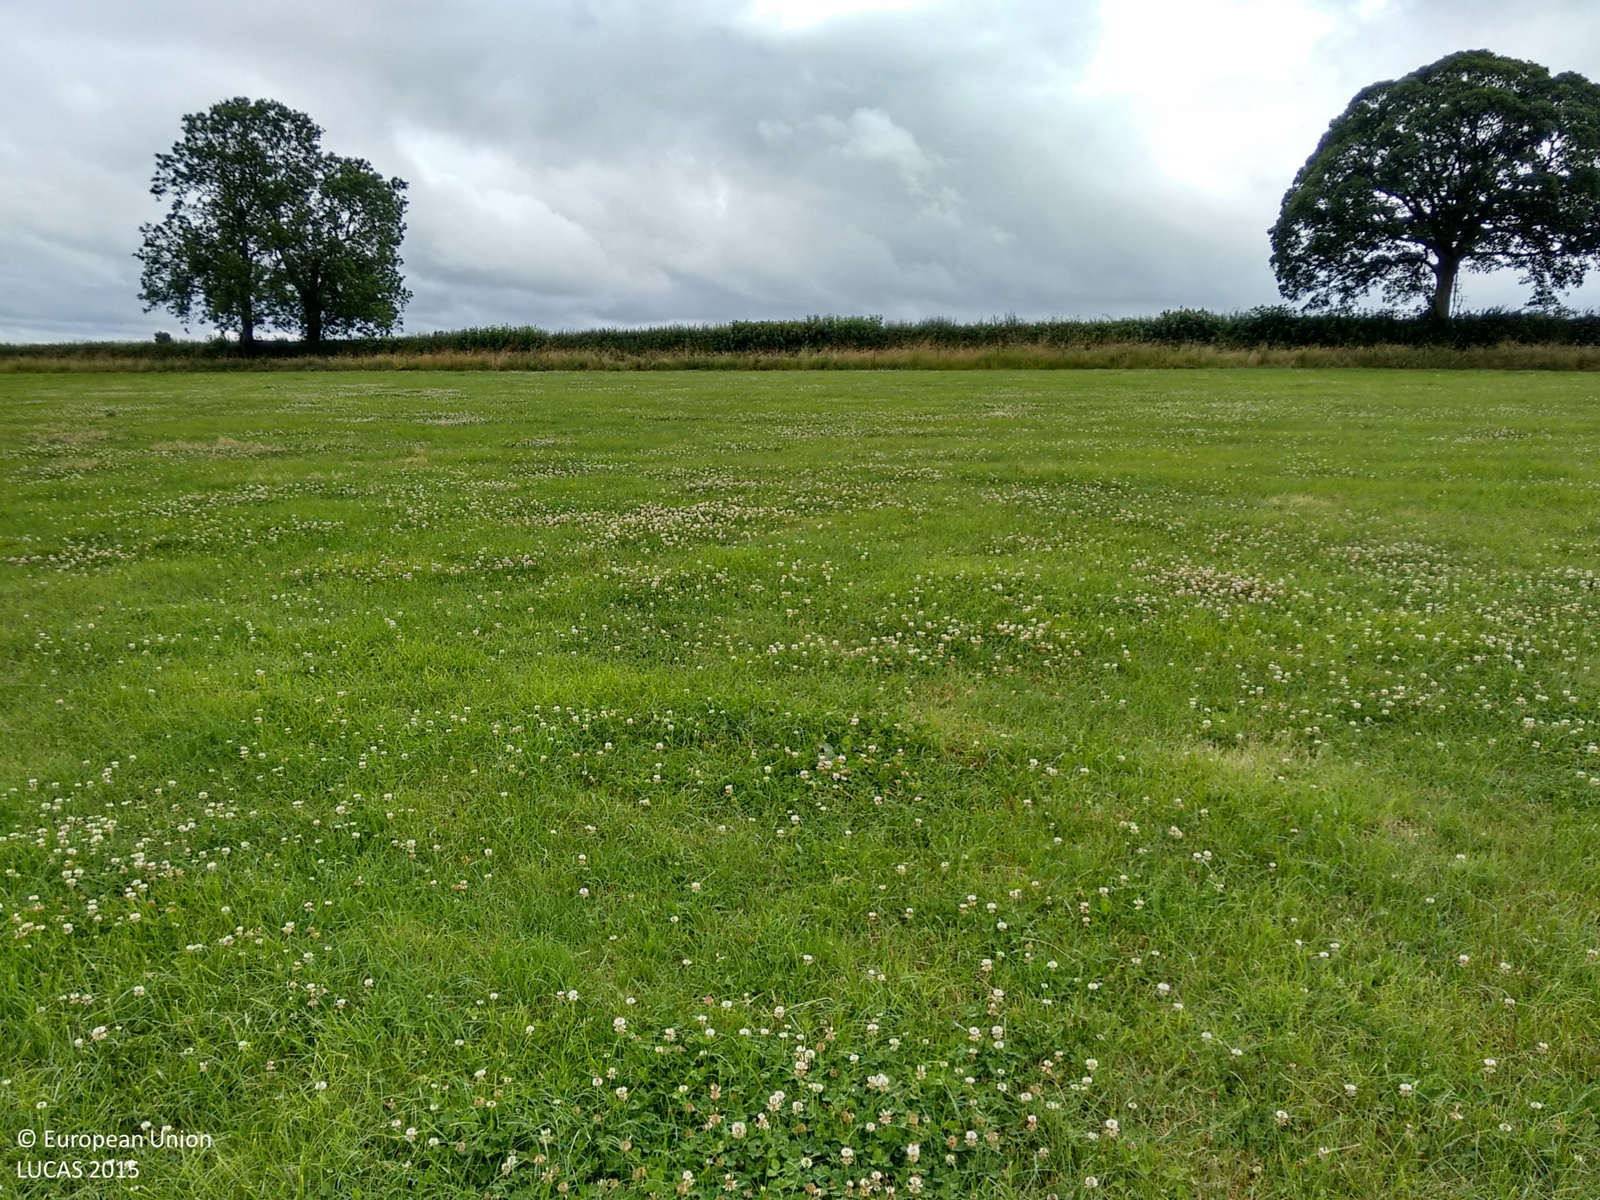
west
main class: Grassland
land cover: Grassland without tree/shrub cover
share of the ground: > 75 %
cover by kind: herbaceous plants 100 %
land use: Agriculture (excluding fallow land and kitchen gardens)
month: July
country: GB
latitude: 52.1227
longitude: -1.3392
